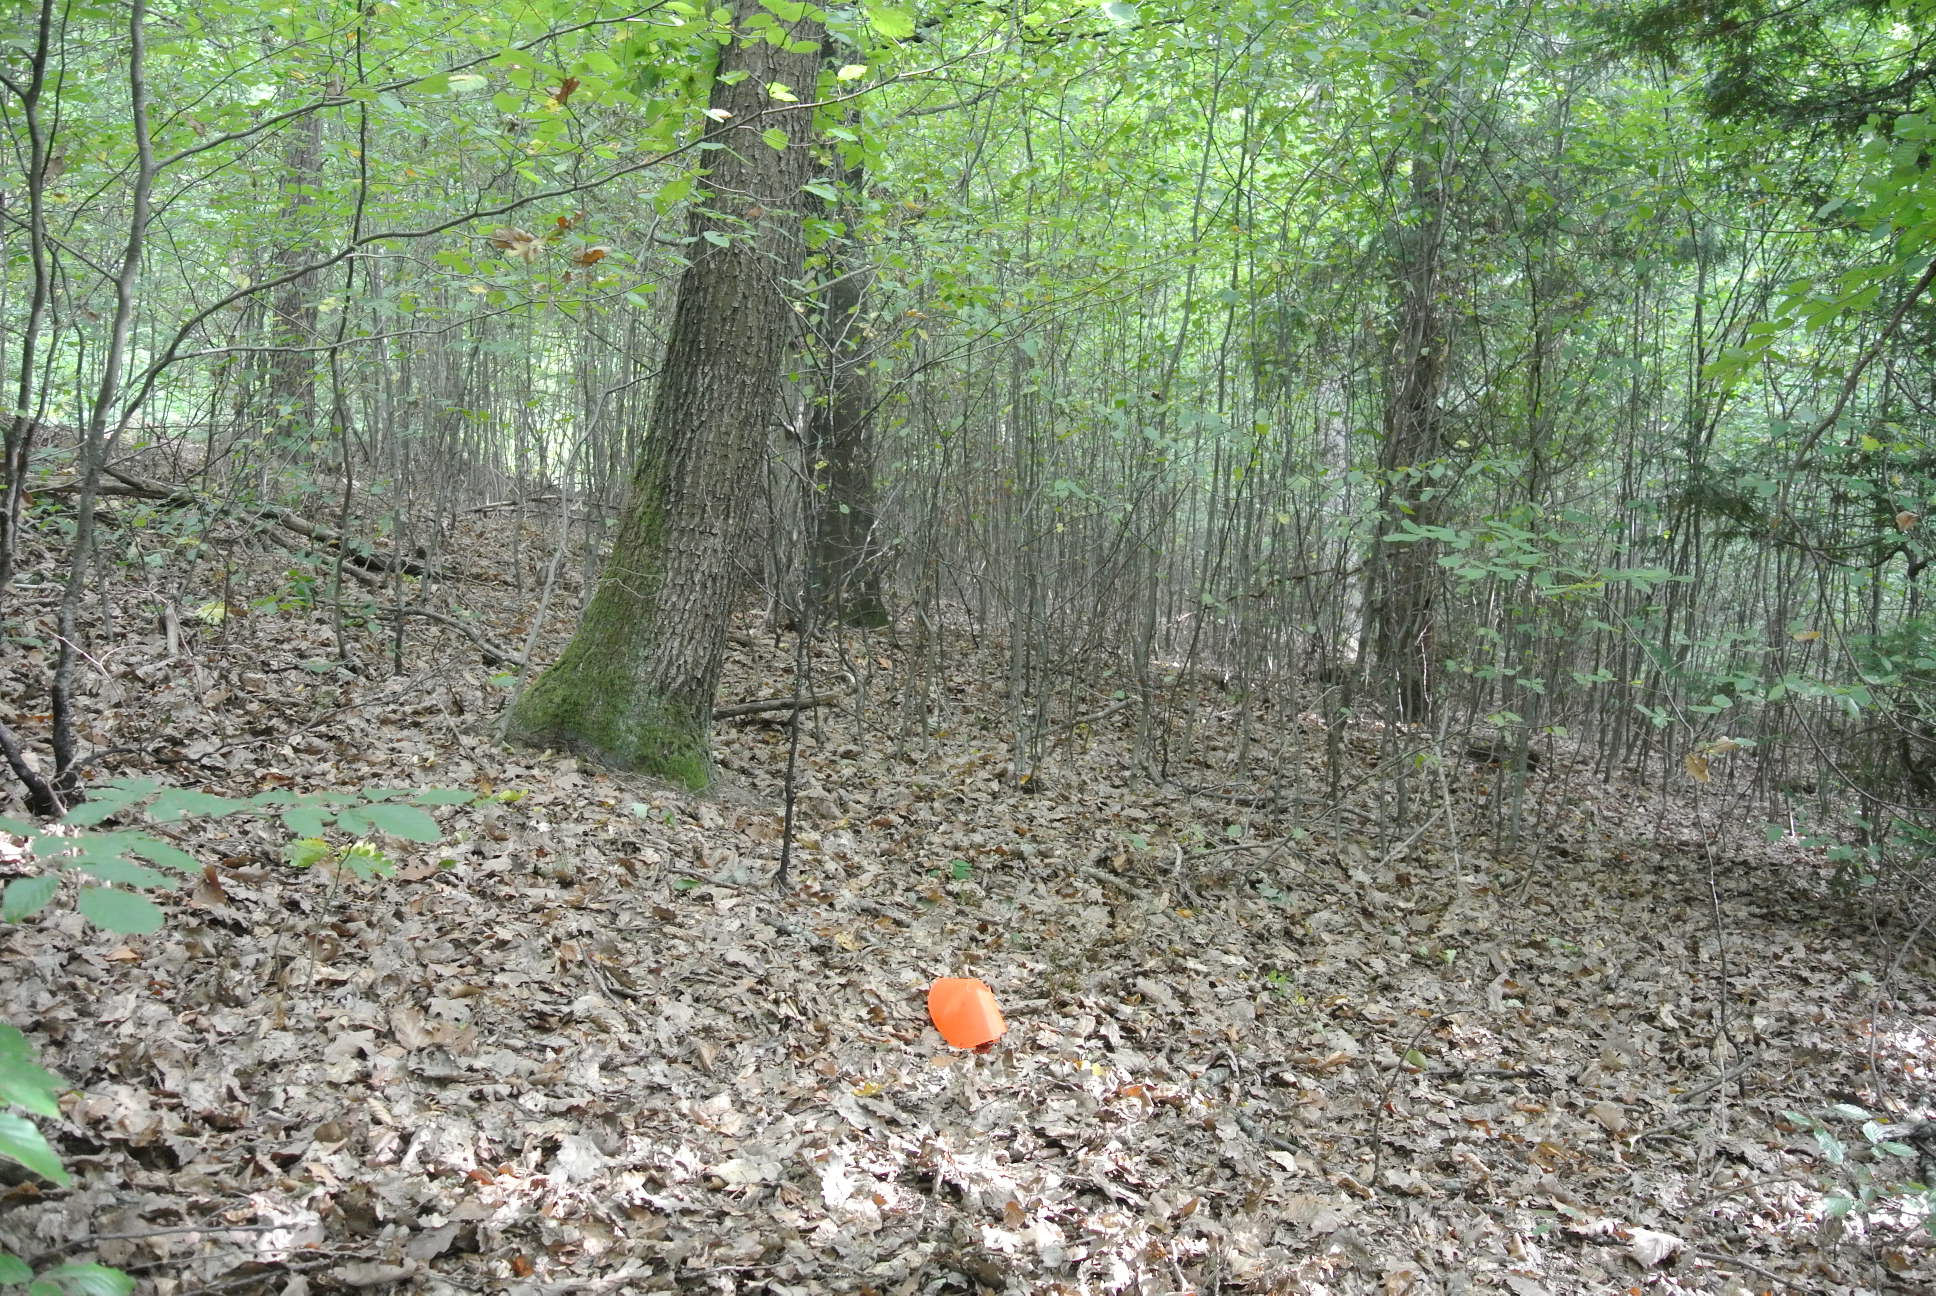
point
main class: Woodland
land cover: Broadleaved woodland
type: beech forest
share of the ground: > 75 %
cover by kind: broadleaved forest trees 95 %, coniferous forest trees 5 %
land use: Forestry
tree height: > 5 m
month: July
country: AT
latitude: 47.4039
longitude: 16.4301
